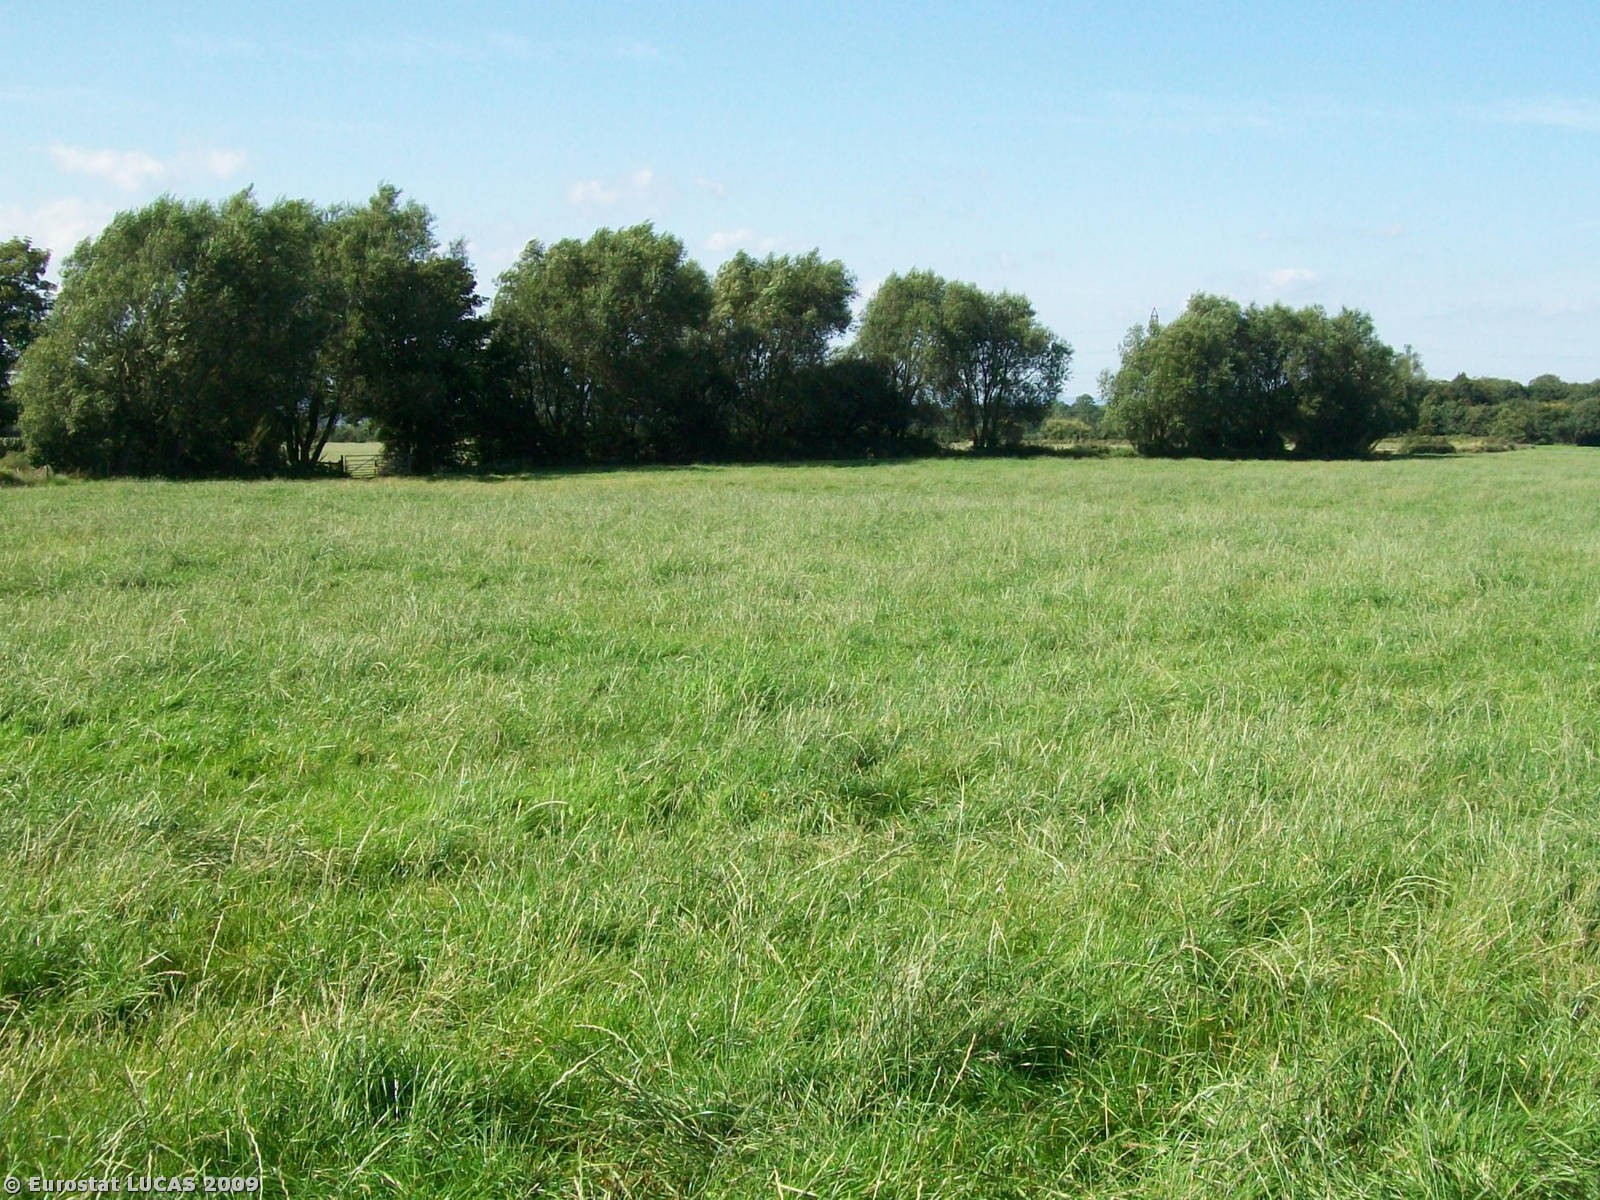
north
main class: Grassland
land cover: Grassland without tree/shrub cover
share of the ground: > 75 %
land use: Agriculture (excluding fallow land and kitchen gardens)
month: August
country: GB
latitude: 51.7142
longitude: -2.3227
